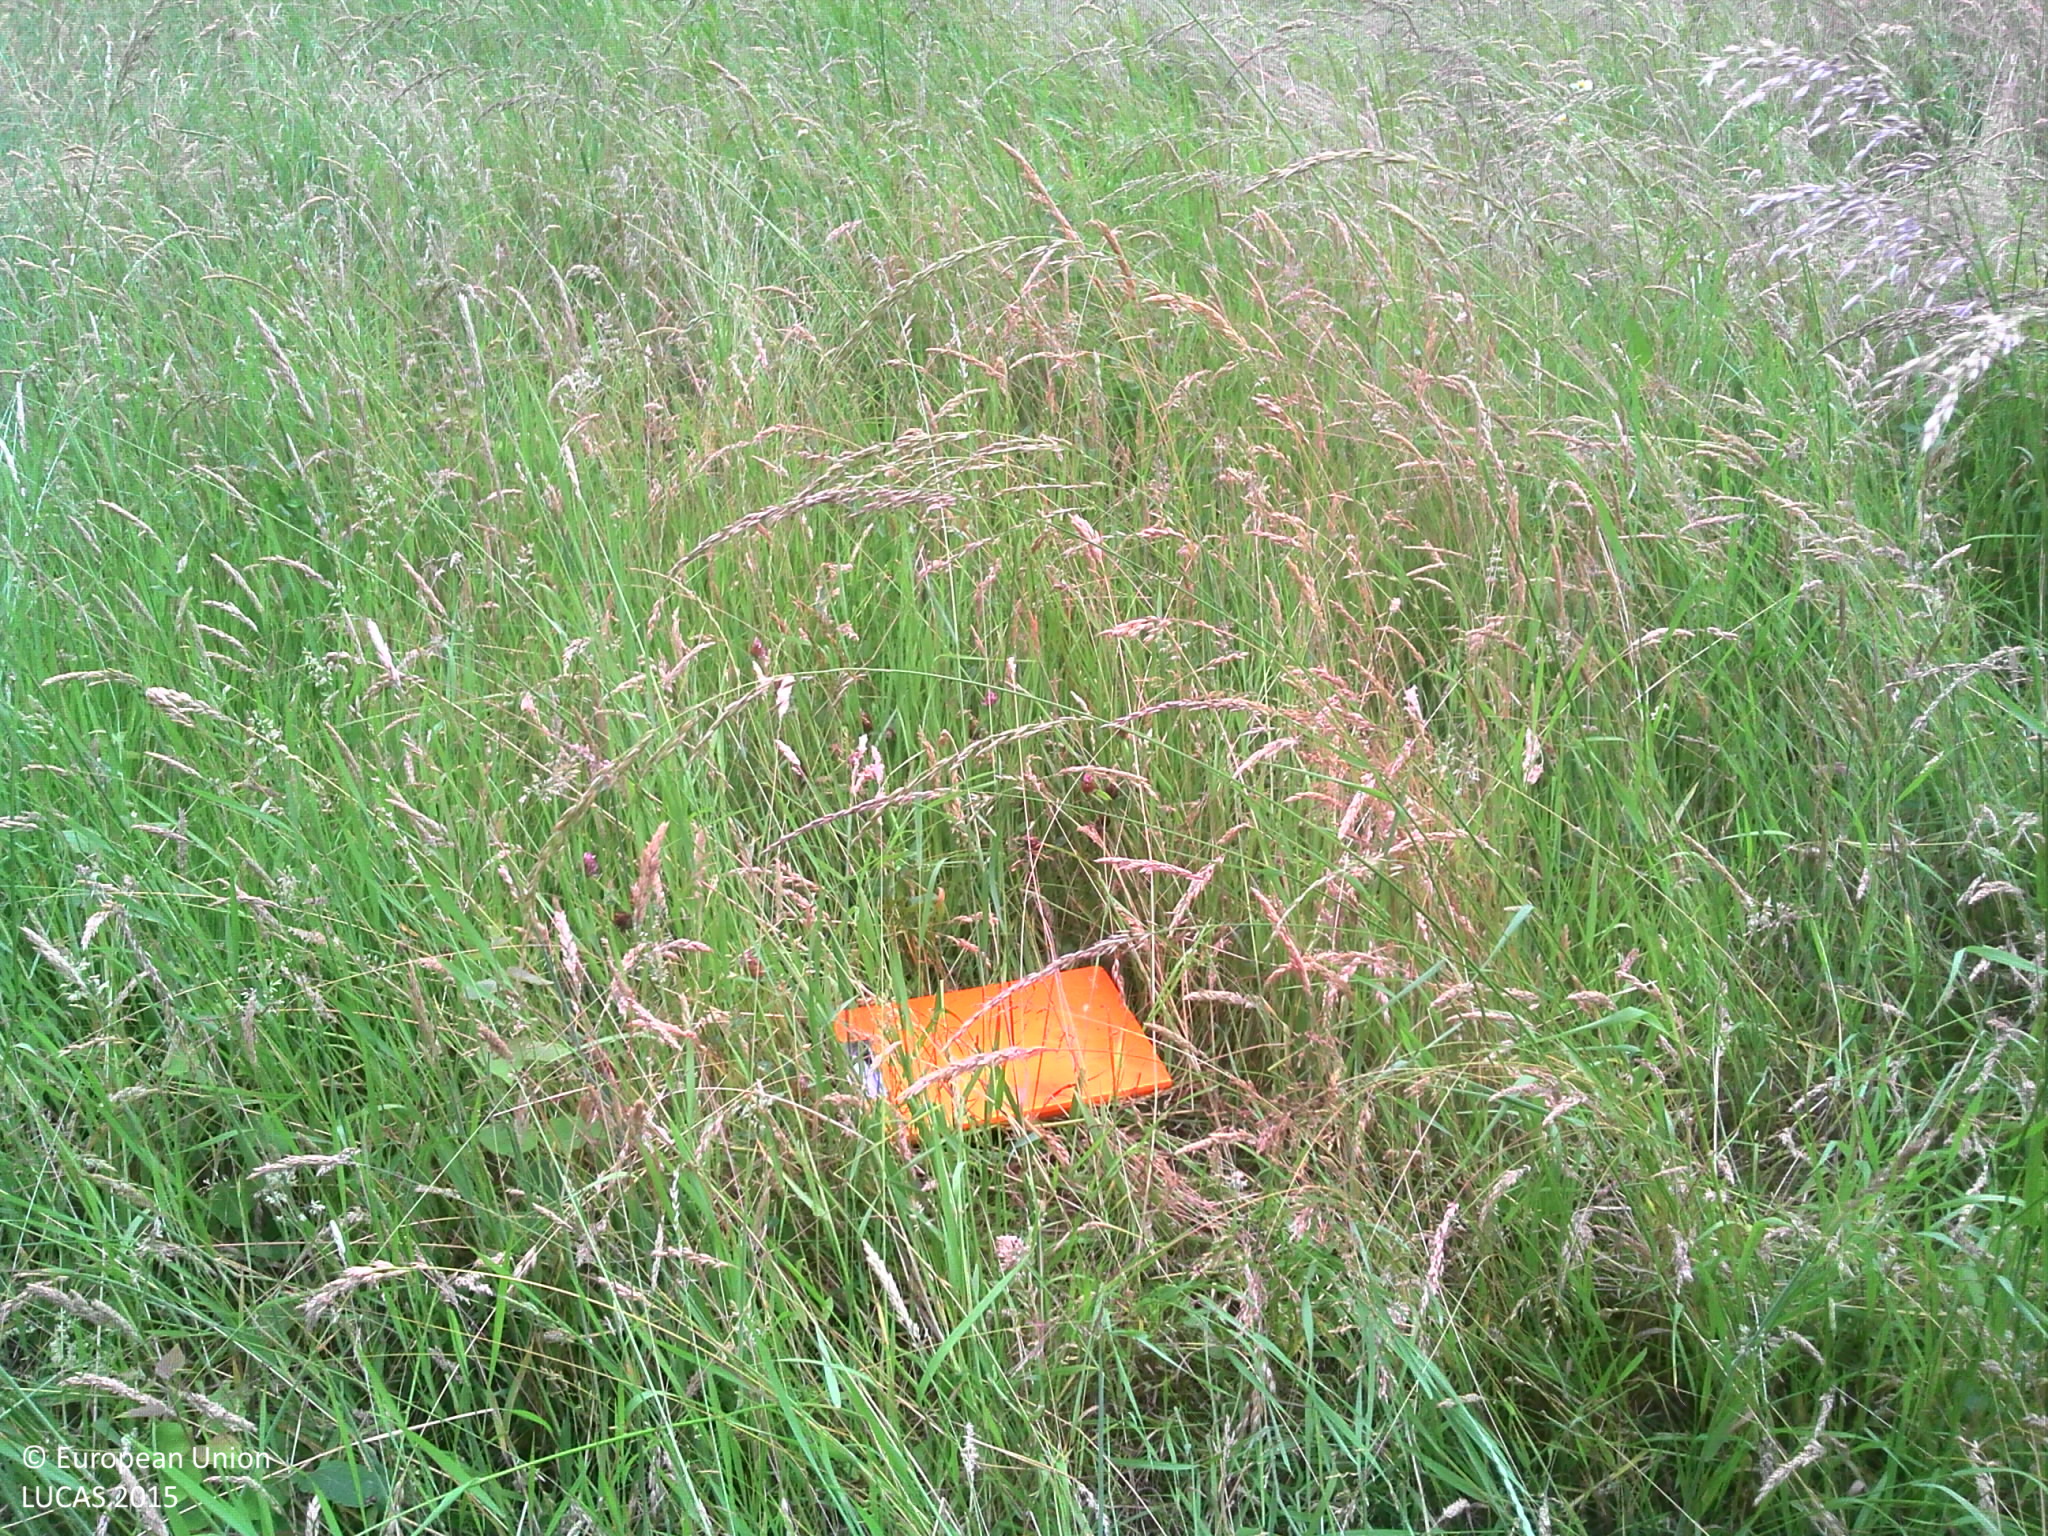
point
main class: Grassland
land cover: Grassland without tree/shrub cover
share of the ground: > 75 %
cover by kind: herbaceous plants 100 %
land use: Agriculture (excluding fallow land and kitchen gardens)
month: June
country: FR
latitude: 48.3380
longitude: 4.8583
